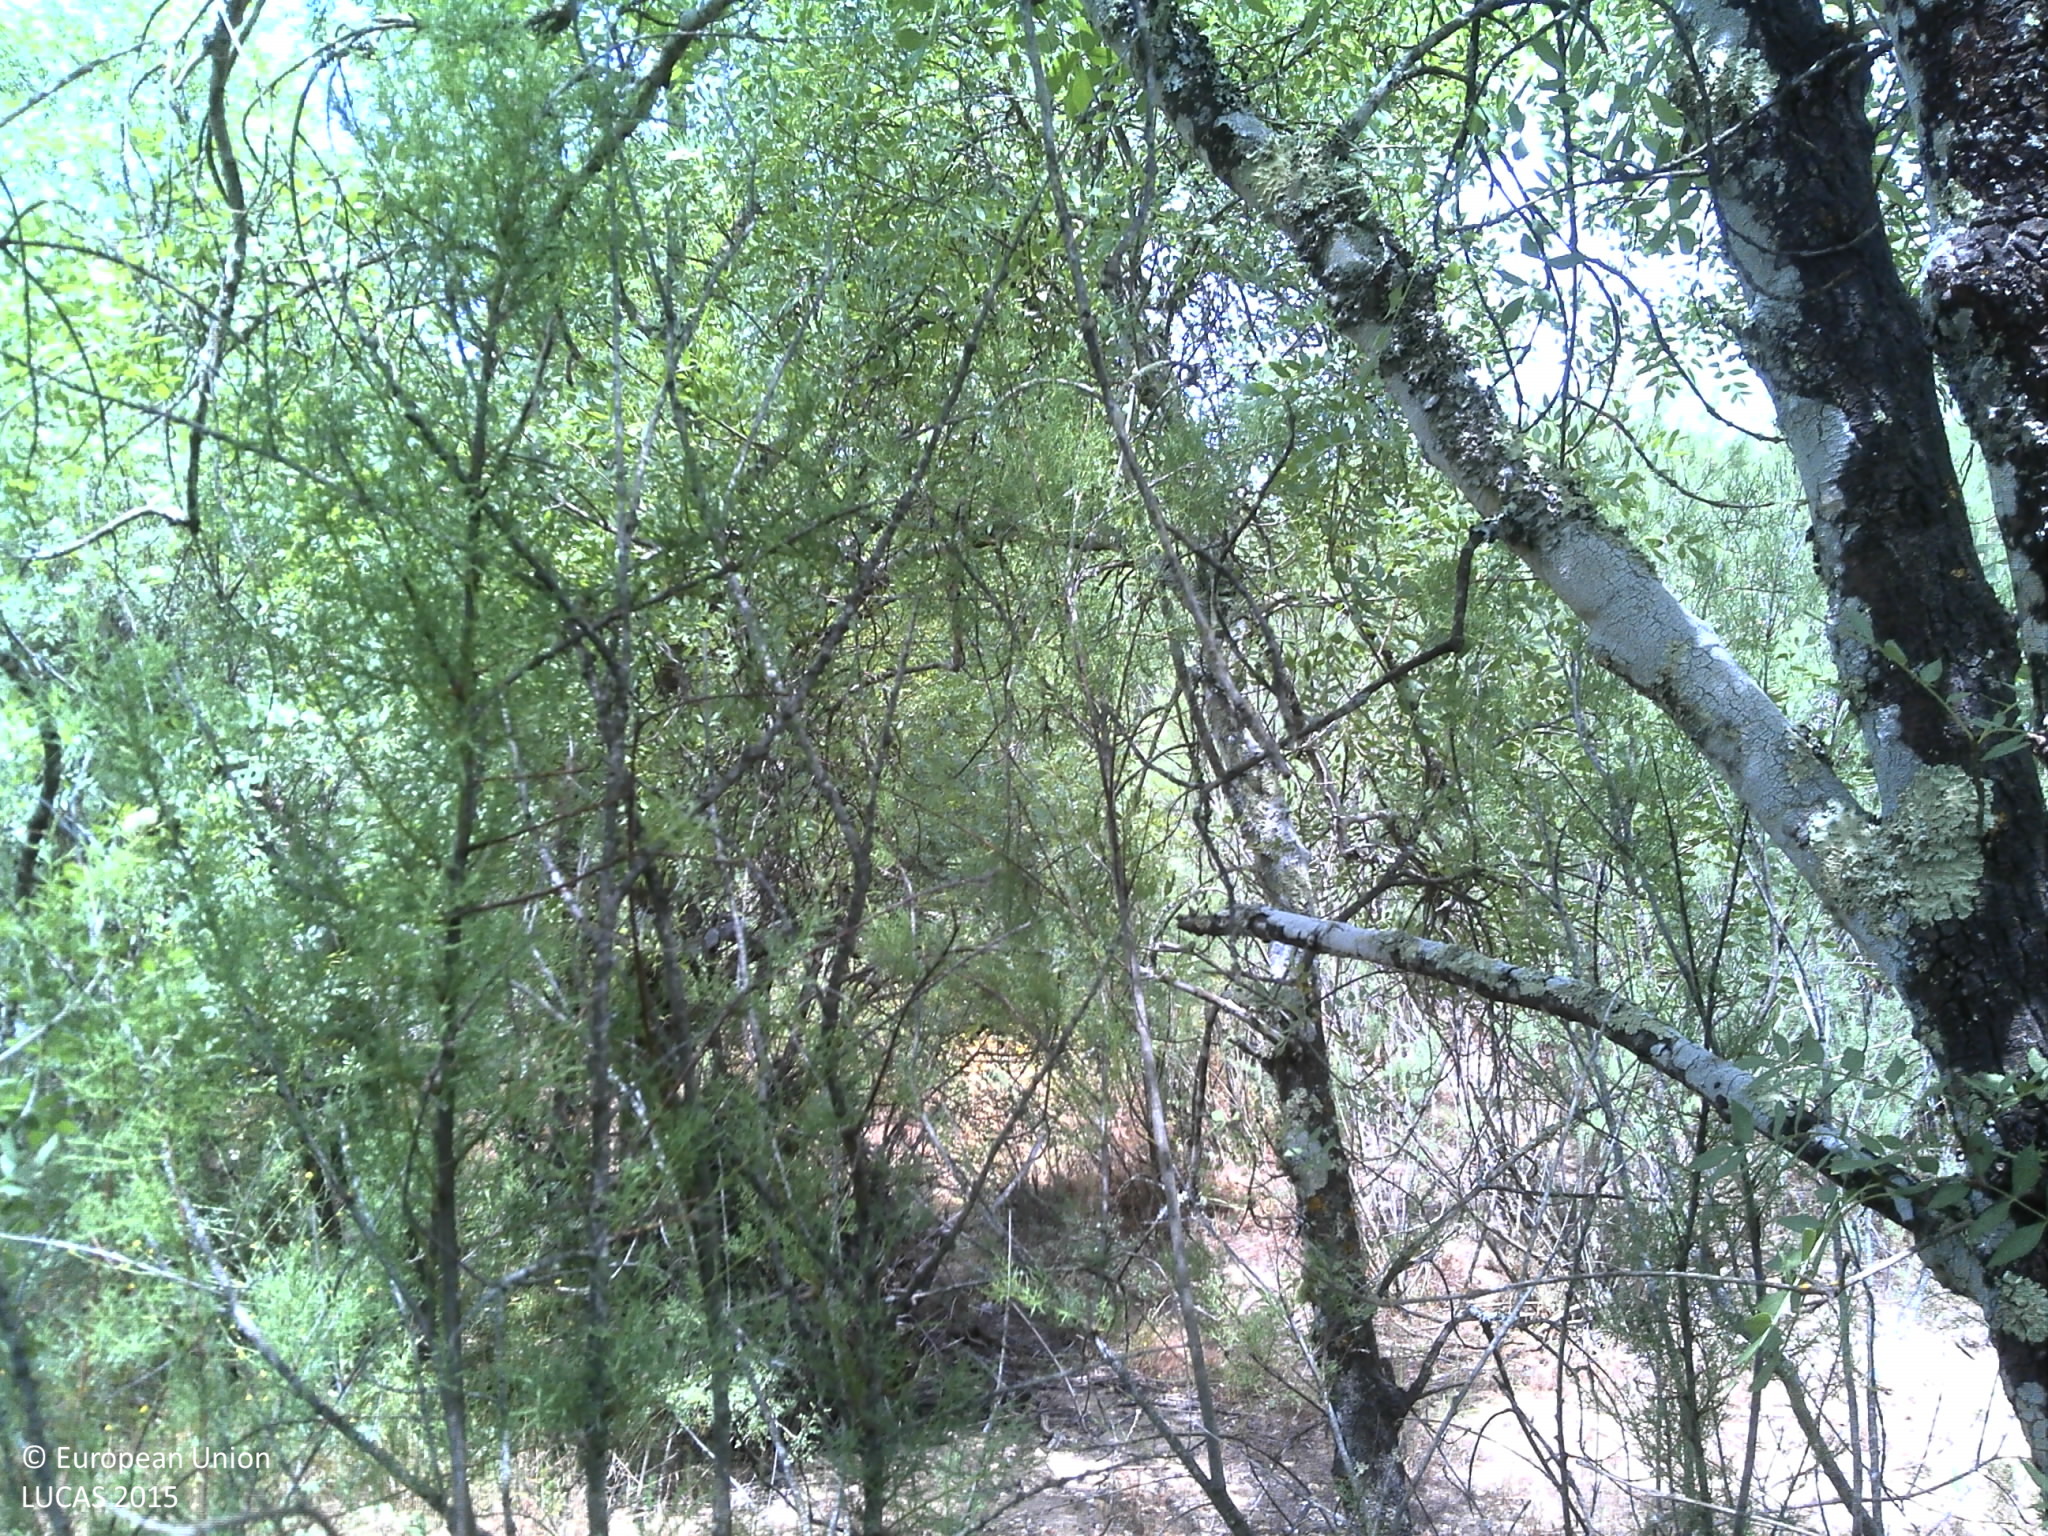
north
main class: Woodland
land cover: Broadleaved woodland
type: floodplain forest
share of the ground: 50 - 75 %
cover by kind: broadleaved forest trees 50 %, shrubs 25 %, unconsolidated bare surface 15 %, herbaceous plants 10 %
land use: Semi-natural and natural areas not in use
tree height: > 5 m
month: May
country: PT
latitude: 38.0342
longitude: -8.3722
